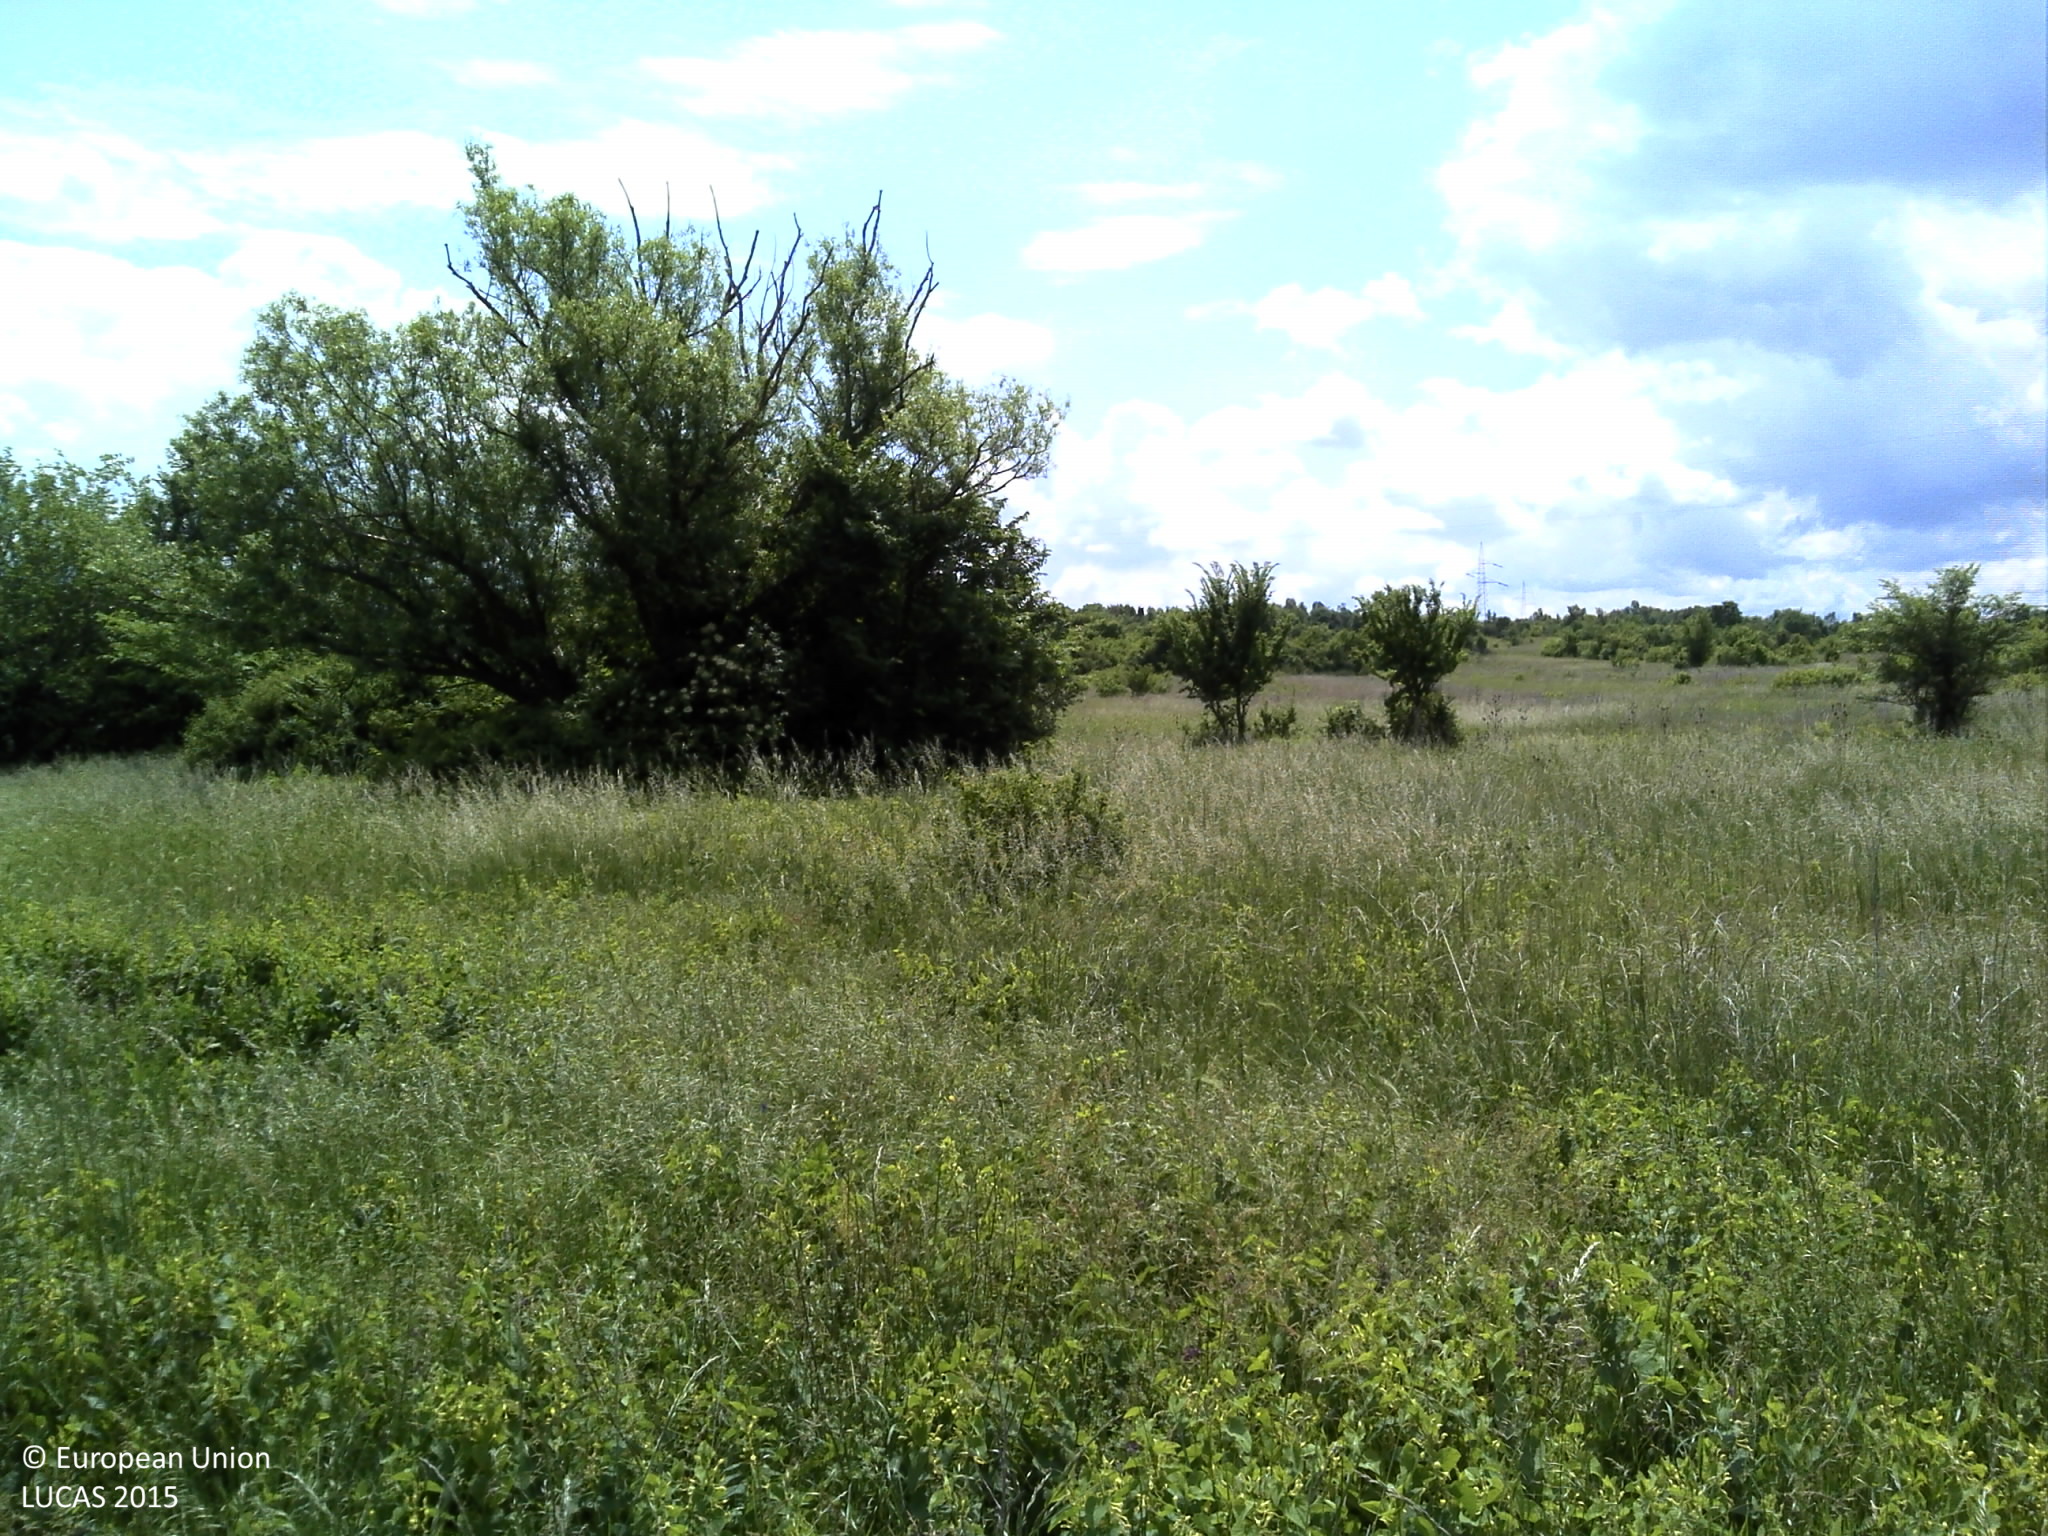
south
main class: Grassland
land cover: Grassland without tree/shrub cover
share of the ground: > 75 %
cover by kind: herbaceous plants 100 %
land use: Abandoned areas
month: May
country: HR
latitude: 44.0014
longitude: 16.2155
